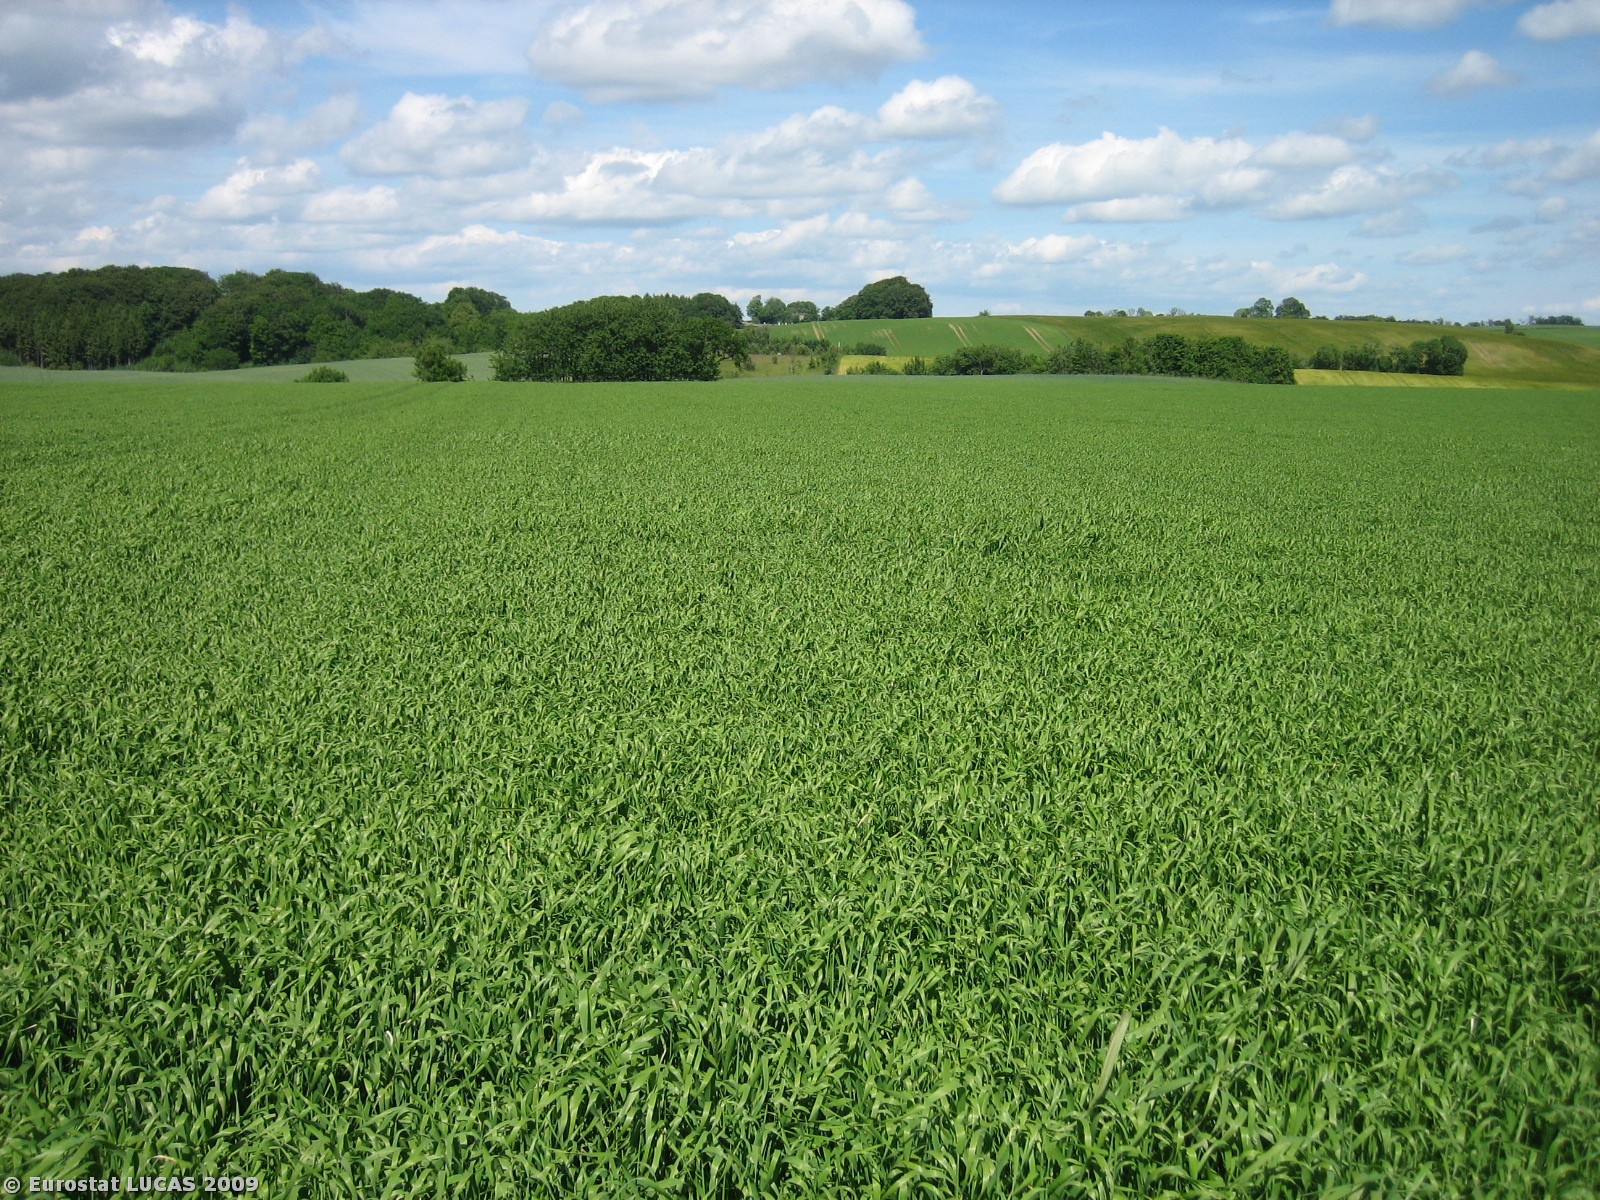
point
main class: Cropland
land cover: Barley
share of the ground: > 75 %
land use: Agriculture (excluding fallow land and kitchen gardens)
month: June
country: DK
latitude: 55.9897
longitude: 9.7278
